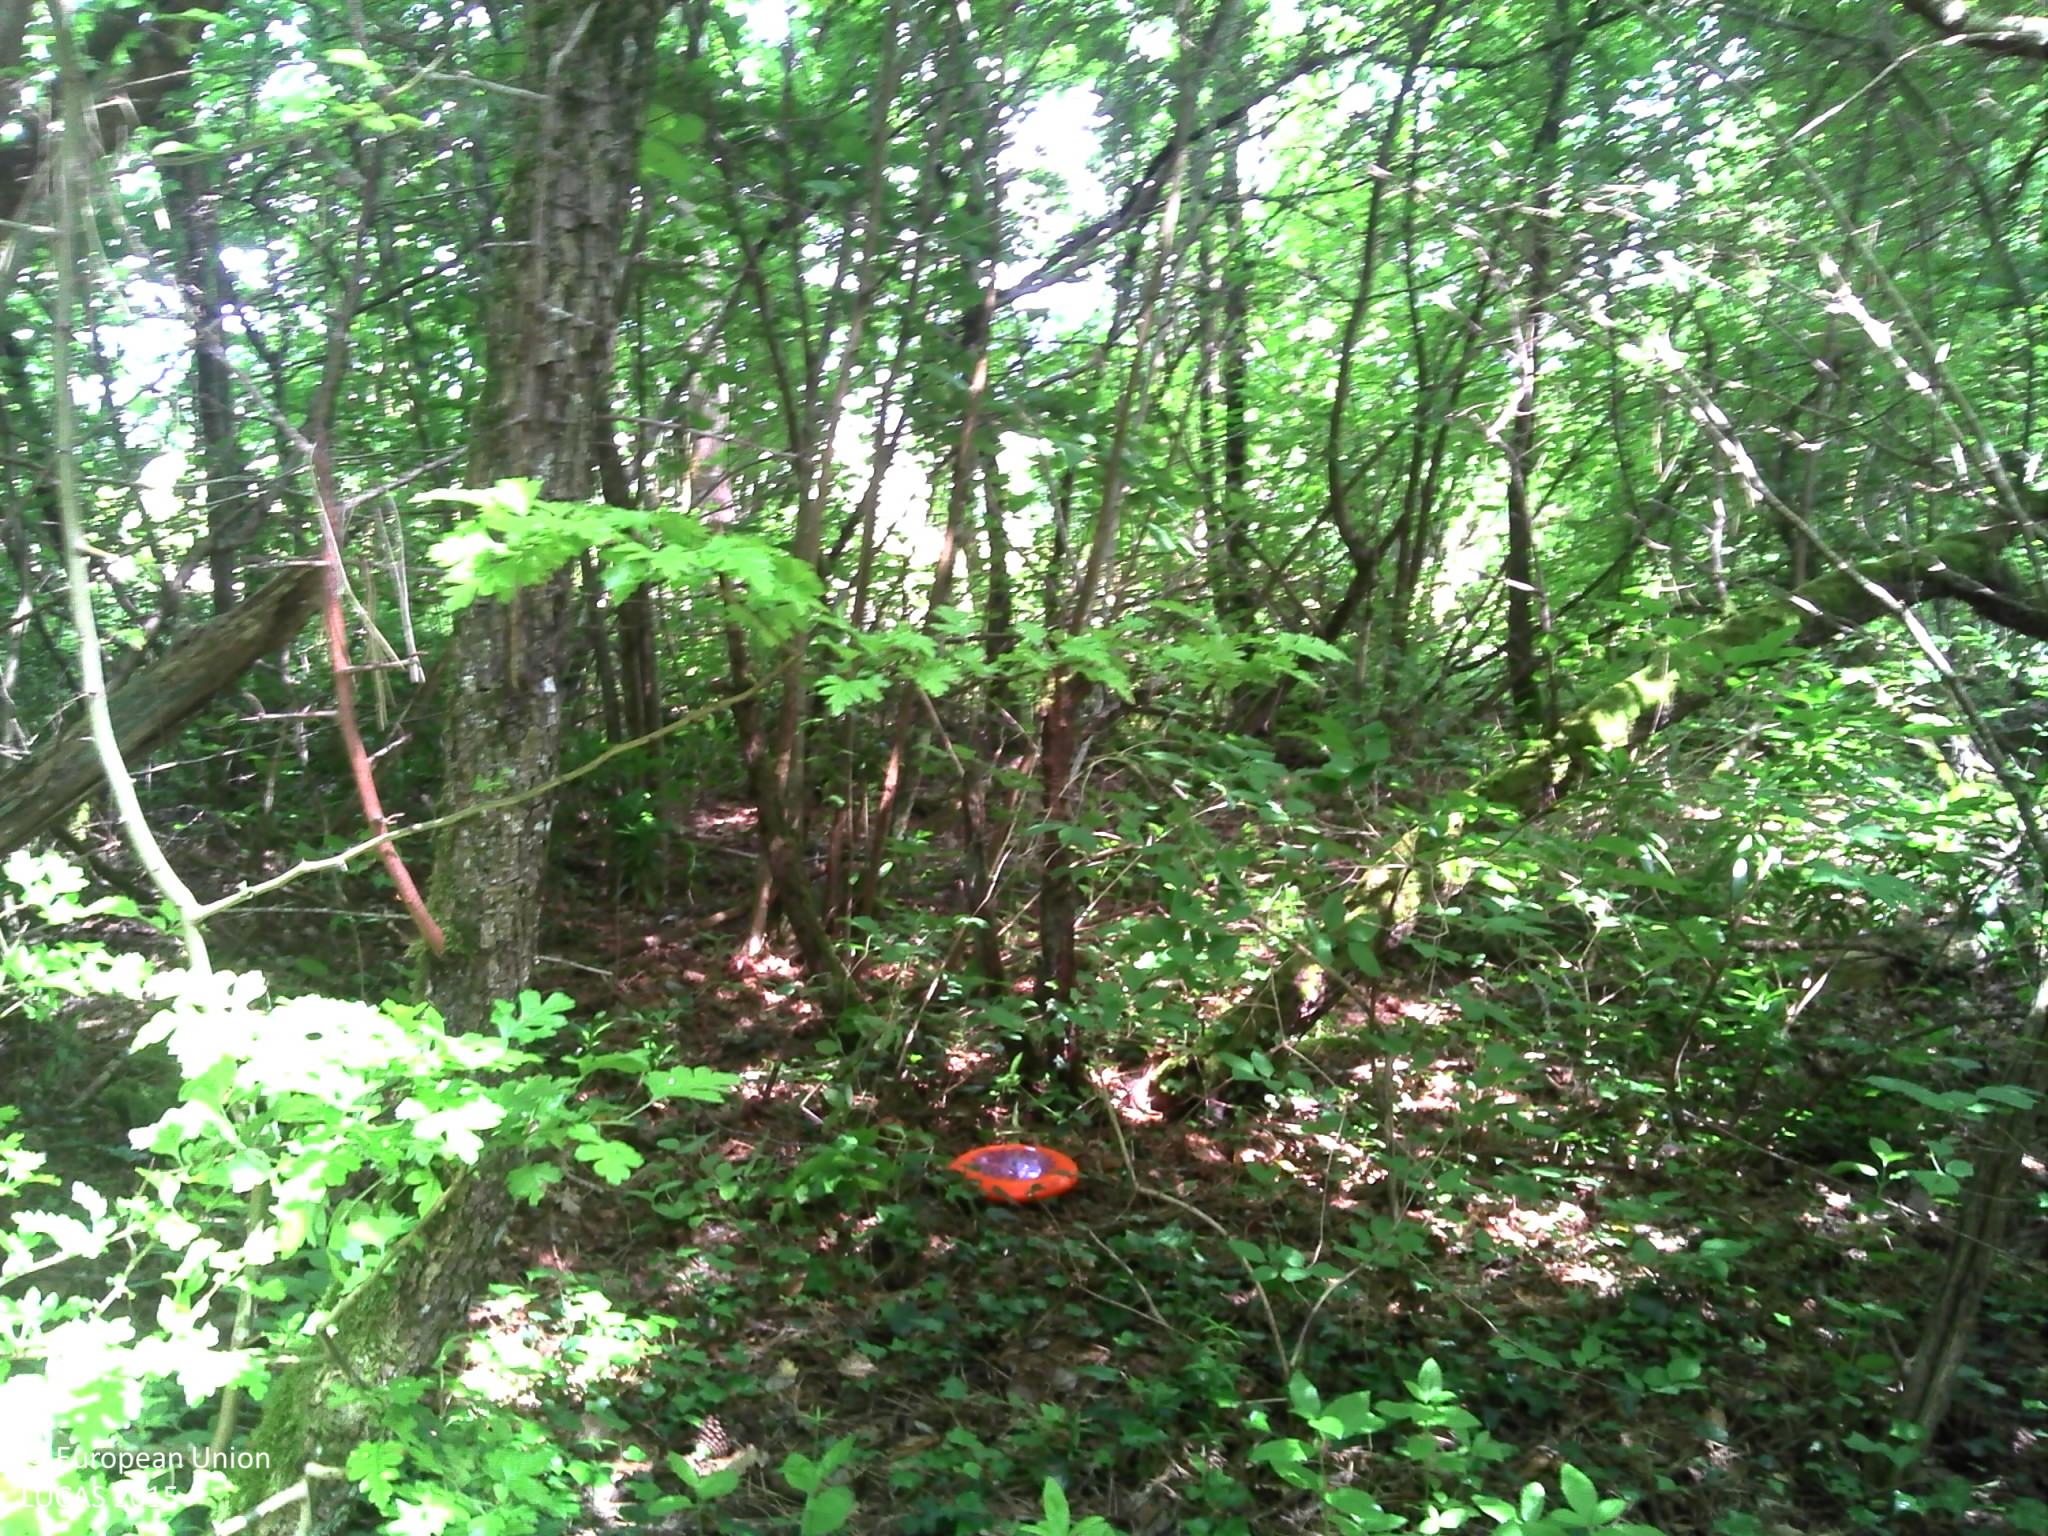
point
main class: Woodland
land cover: Broadleaved woodland
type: acidophilous oak and oak-birch forest
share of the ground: > 75 %
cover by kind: broadleaved forest trees 70 %, coniferous forest trees 20 %, herbaceous plants 5 %, lichens and mosses 5 %
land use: Semi-natural and natural areas not in use
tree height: > 5 m
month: May
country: FR
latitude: 47.7629
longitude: 3.8462
